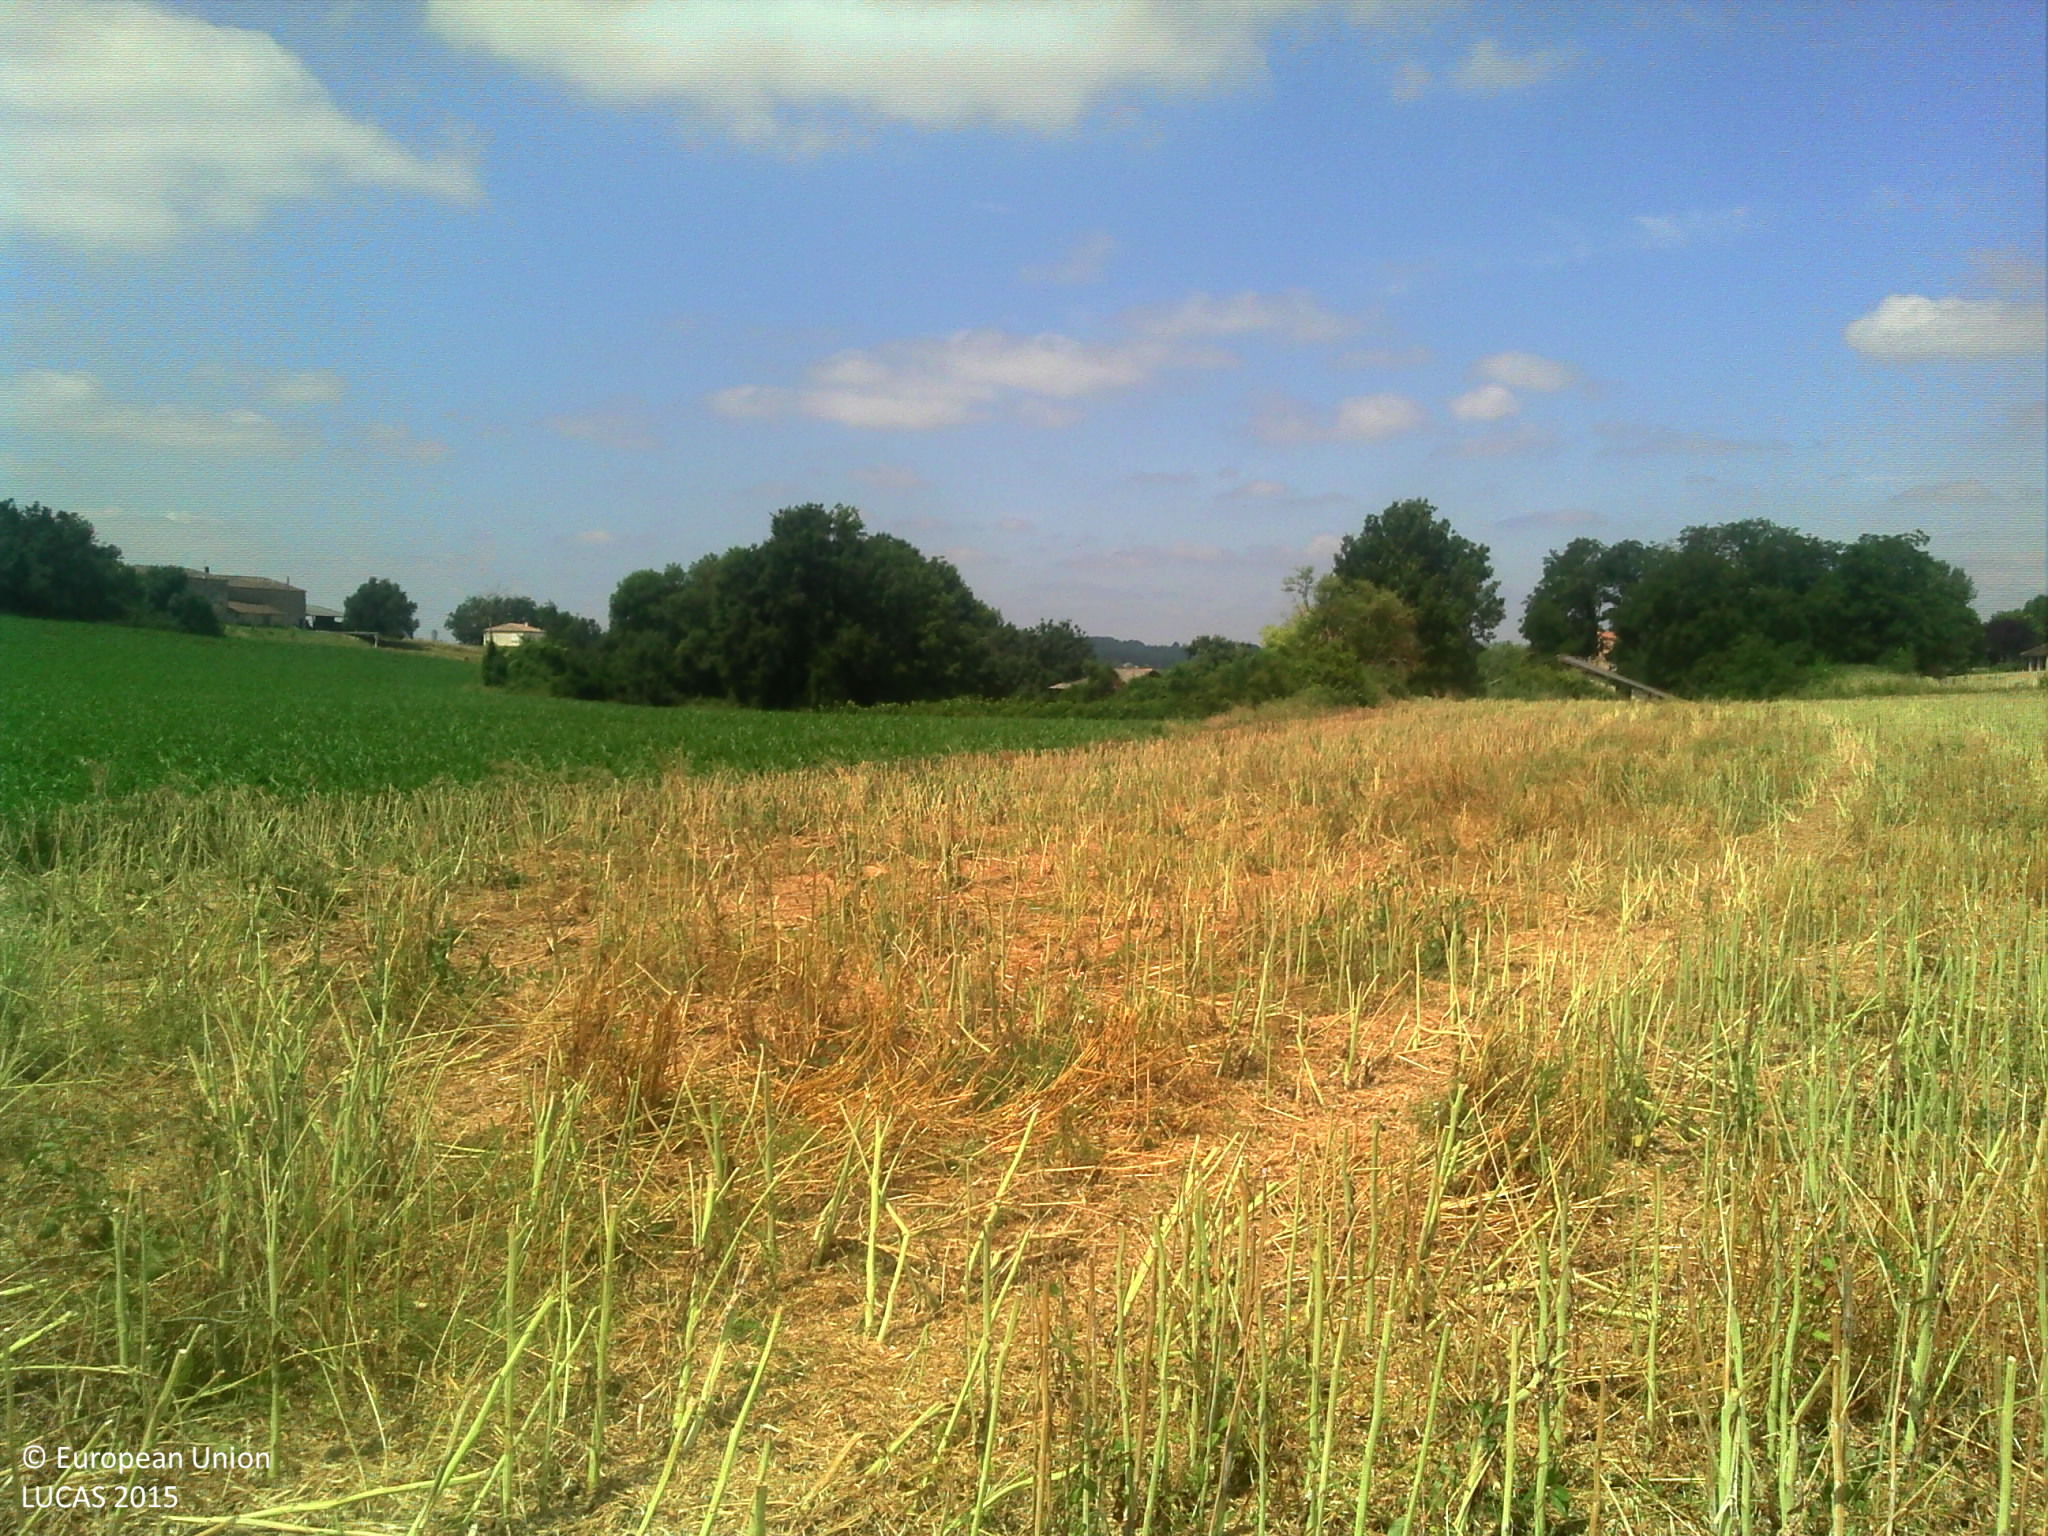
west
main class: Cropland
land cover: Rape and turnip rape
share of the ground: 25 - 50 %
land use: Agriculture (excluding fallow land and kitchen gardens)
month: June
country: FR
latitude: 44.1524
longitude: 0.9323
